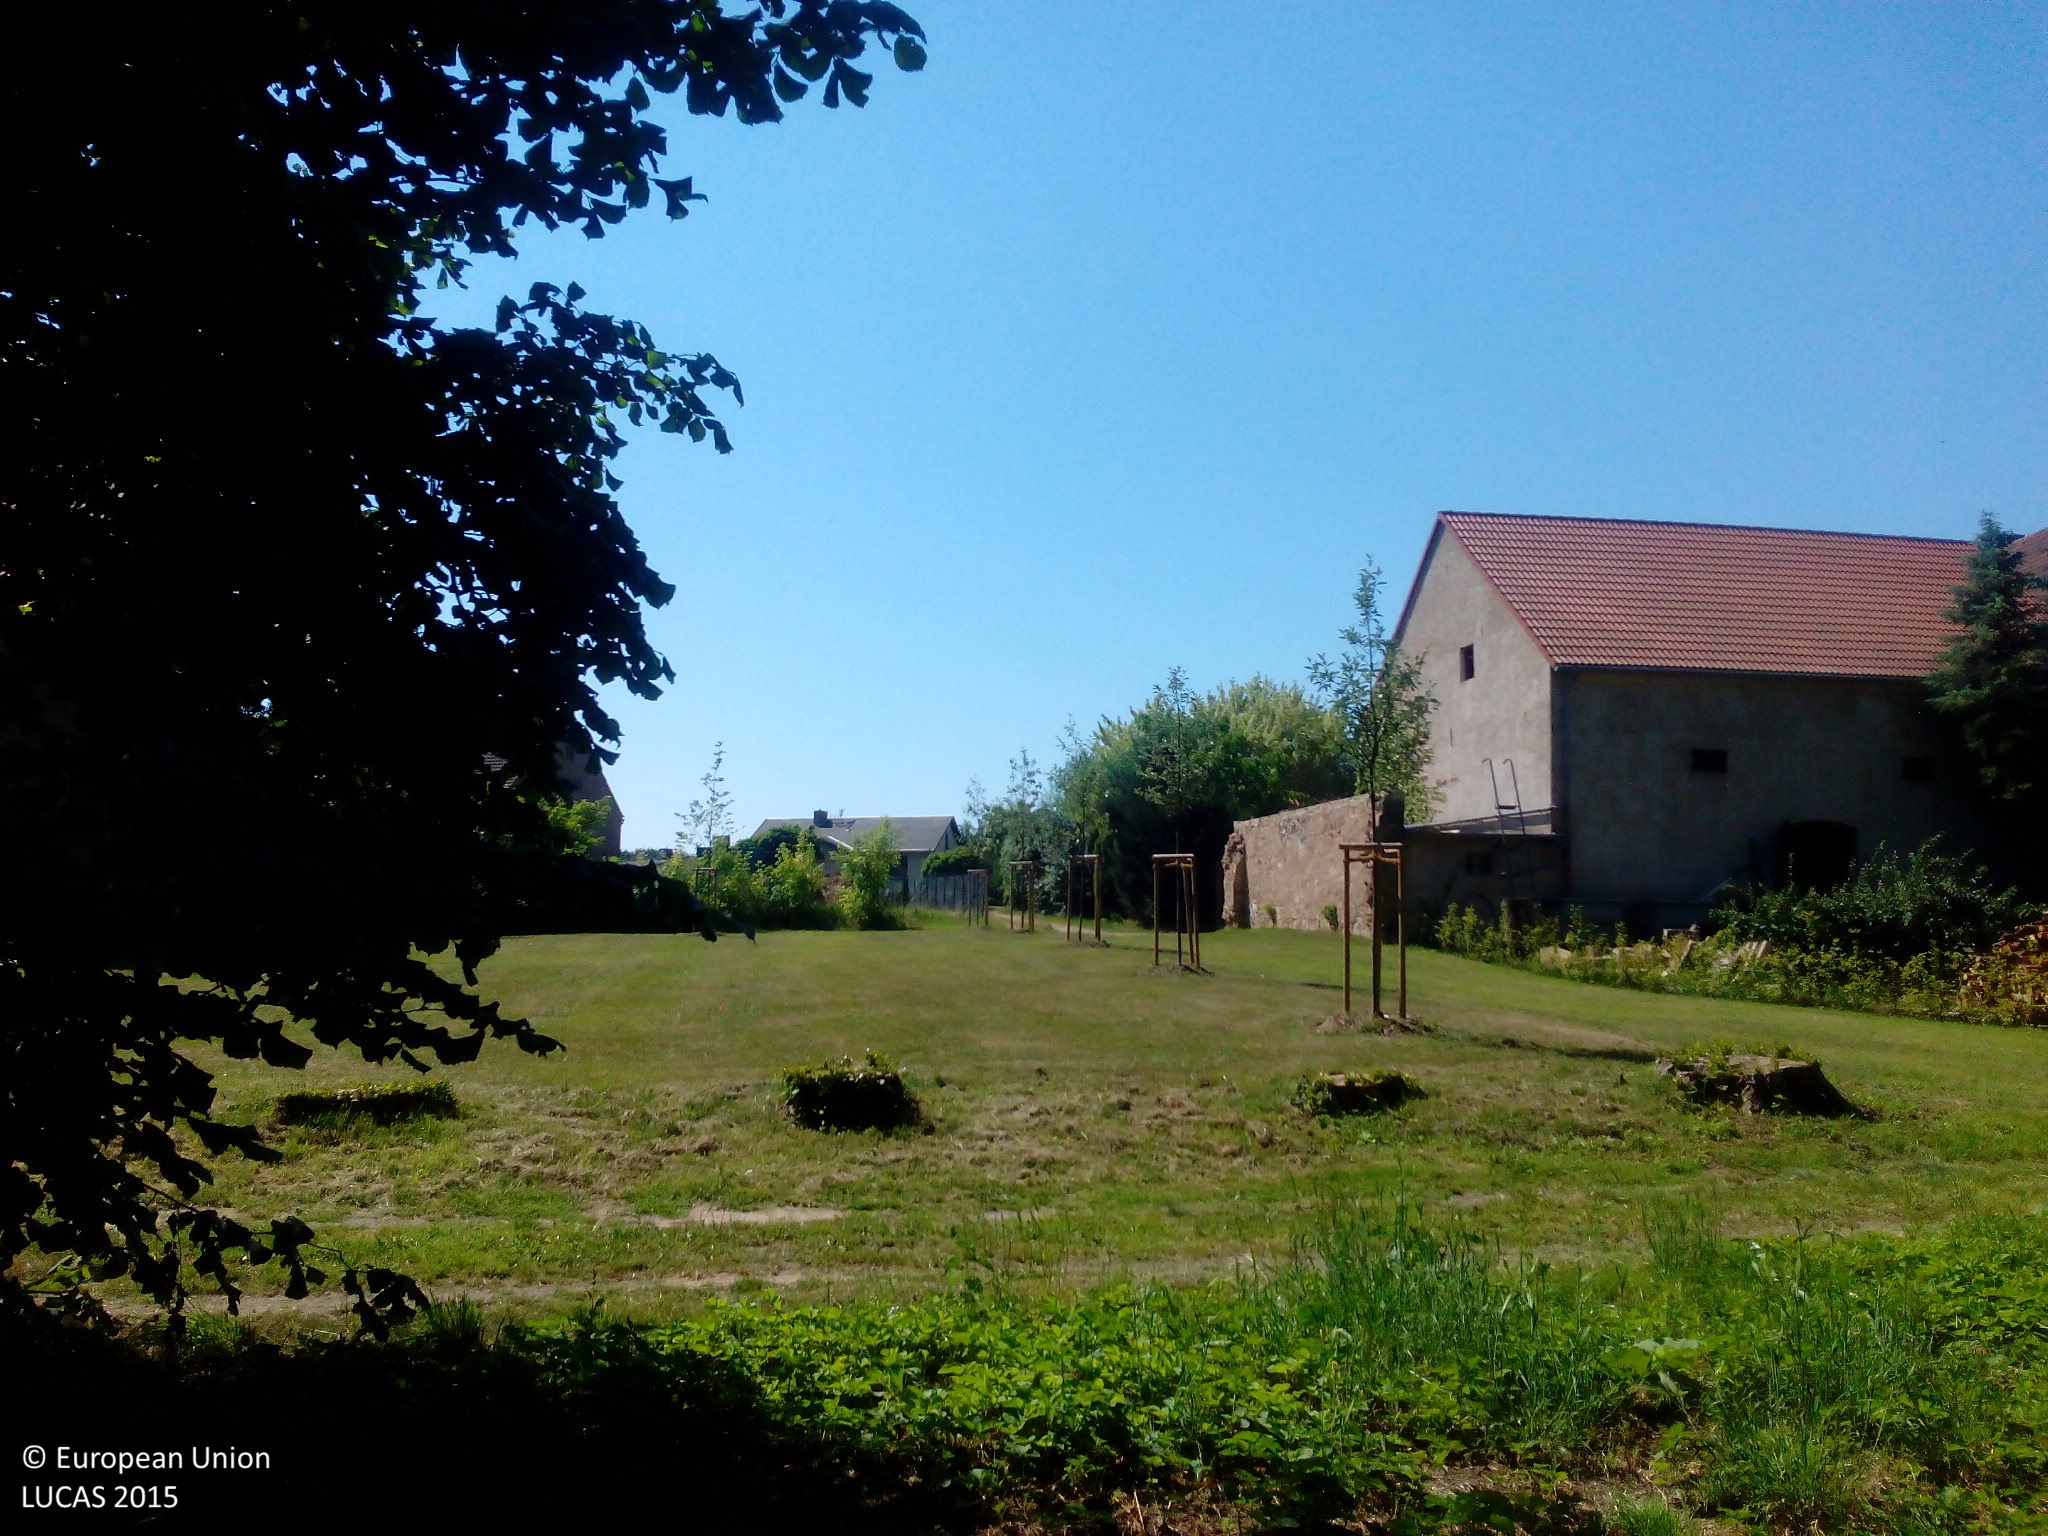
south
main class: Woodland
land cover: Broadleaved woodland
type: mesophytic deciduous forest
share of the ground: > 75 %
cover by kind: broadleaved forest trees 90 %, herbaceous plants 10 %
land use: Forestry
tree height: > 5 m
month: July
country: DE
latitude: 51.2574
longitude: 13.1096
